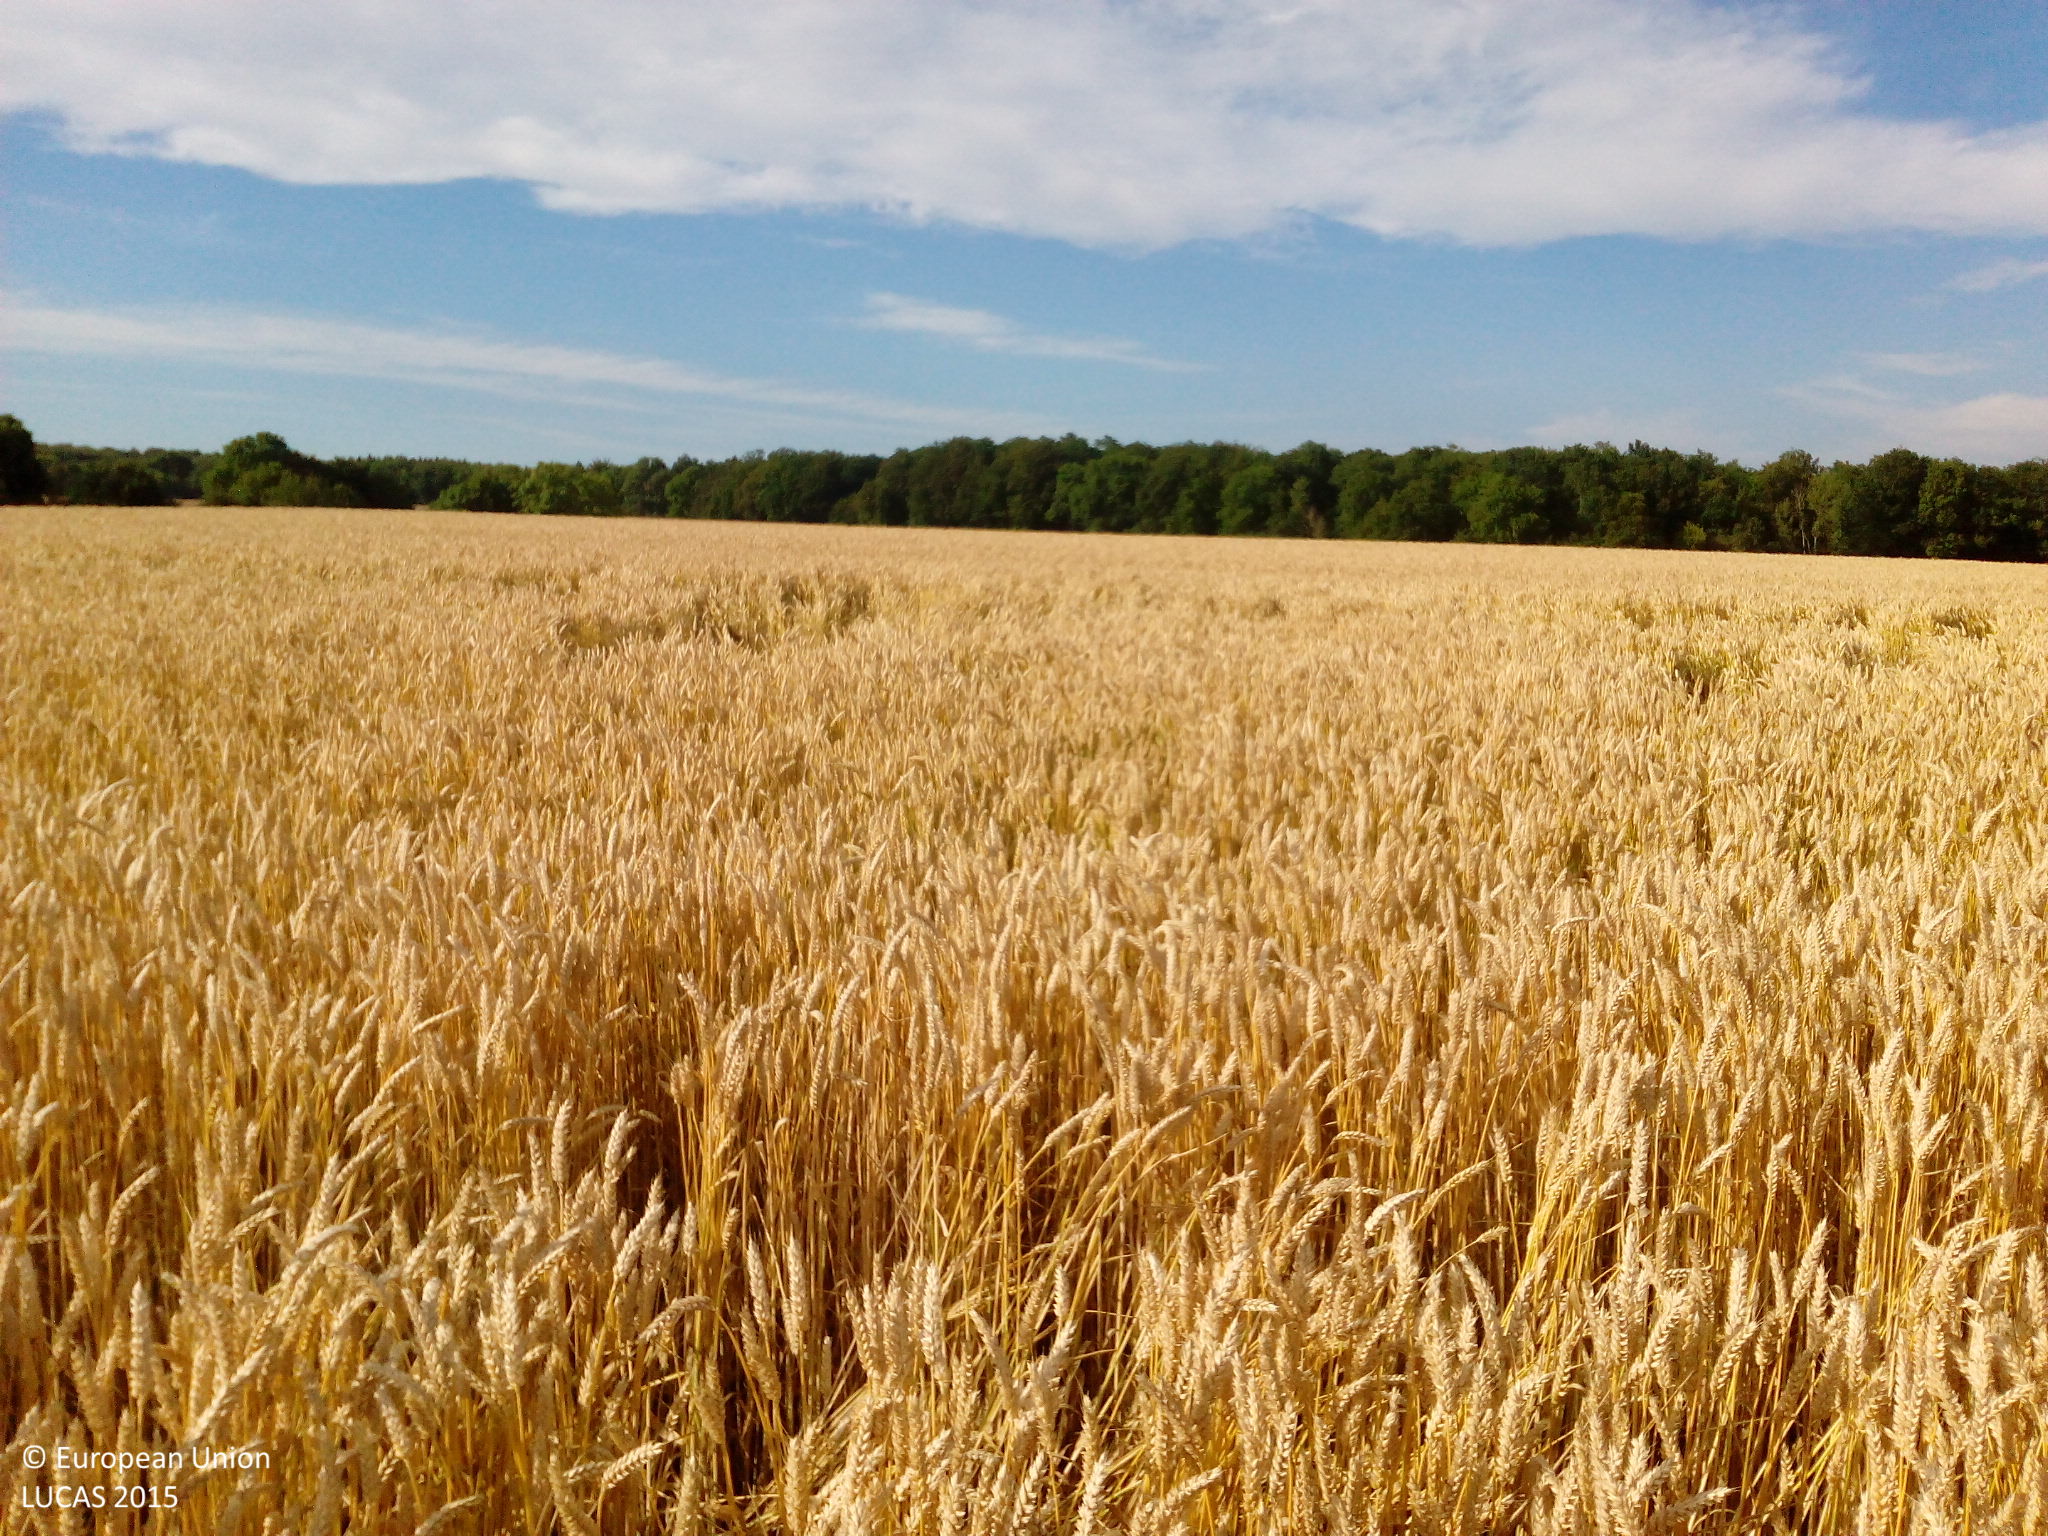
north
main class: Cropland
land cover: Common wheat
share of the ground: > 75 %
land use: Agriculture (excluding fallow land and kitchen gardens)
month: August
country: DK
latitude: 55.6016
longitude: 11.6650
